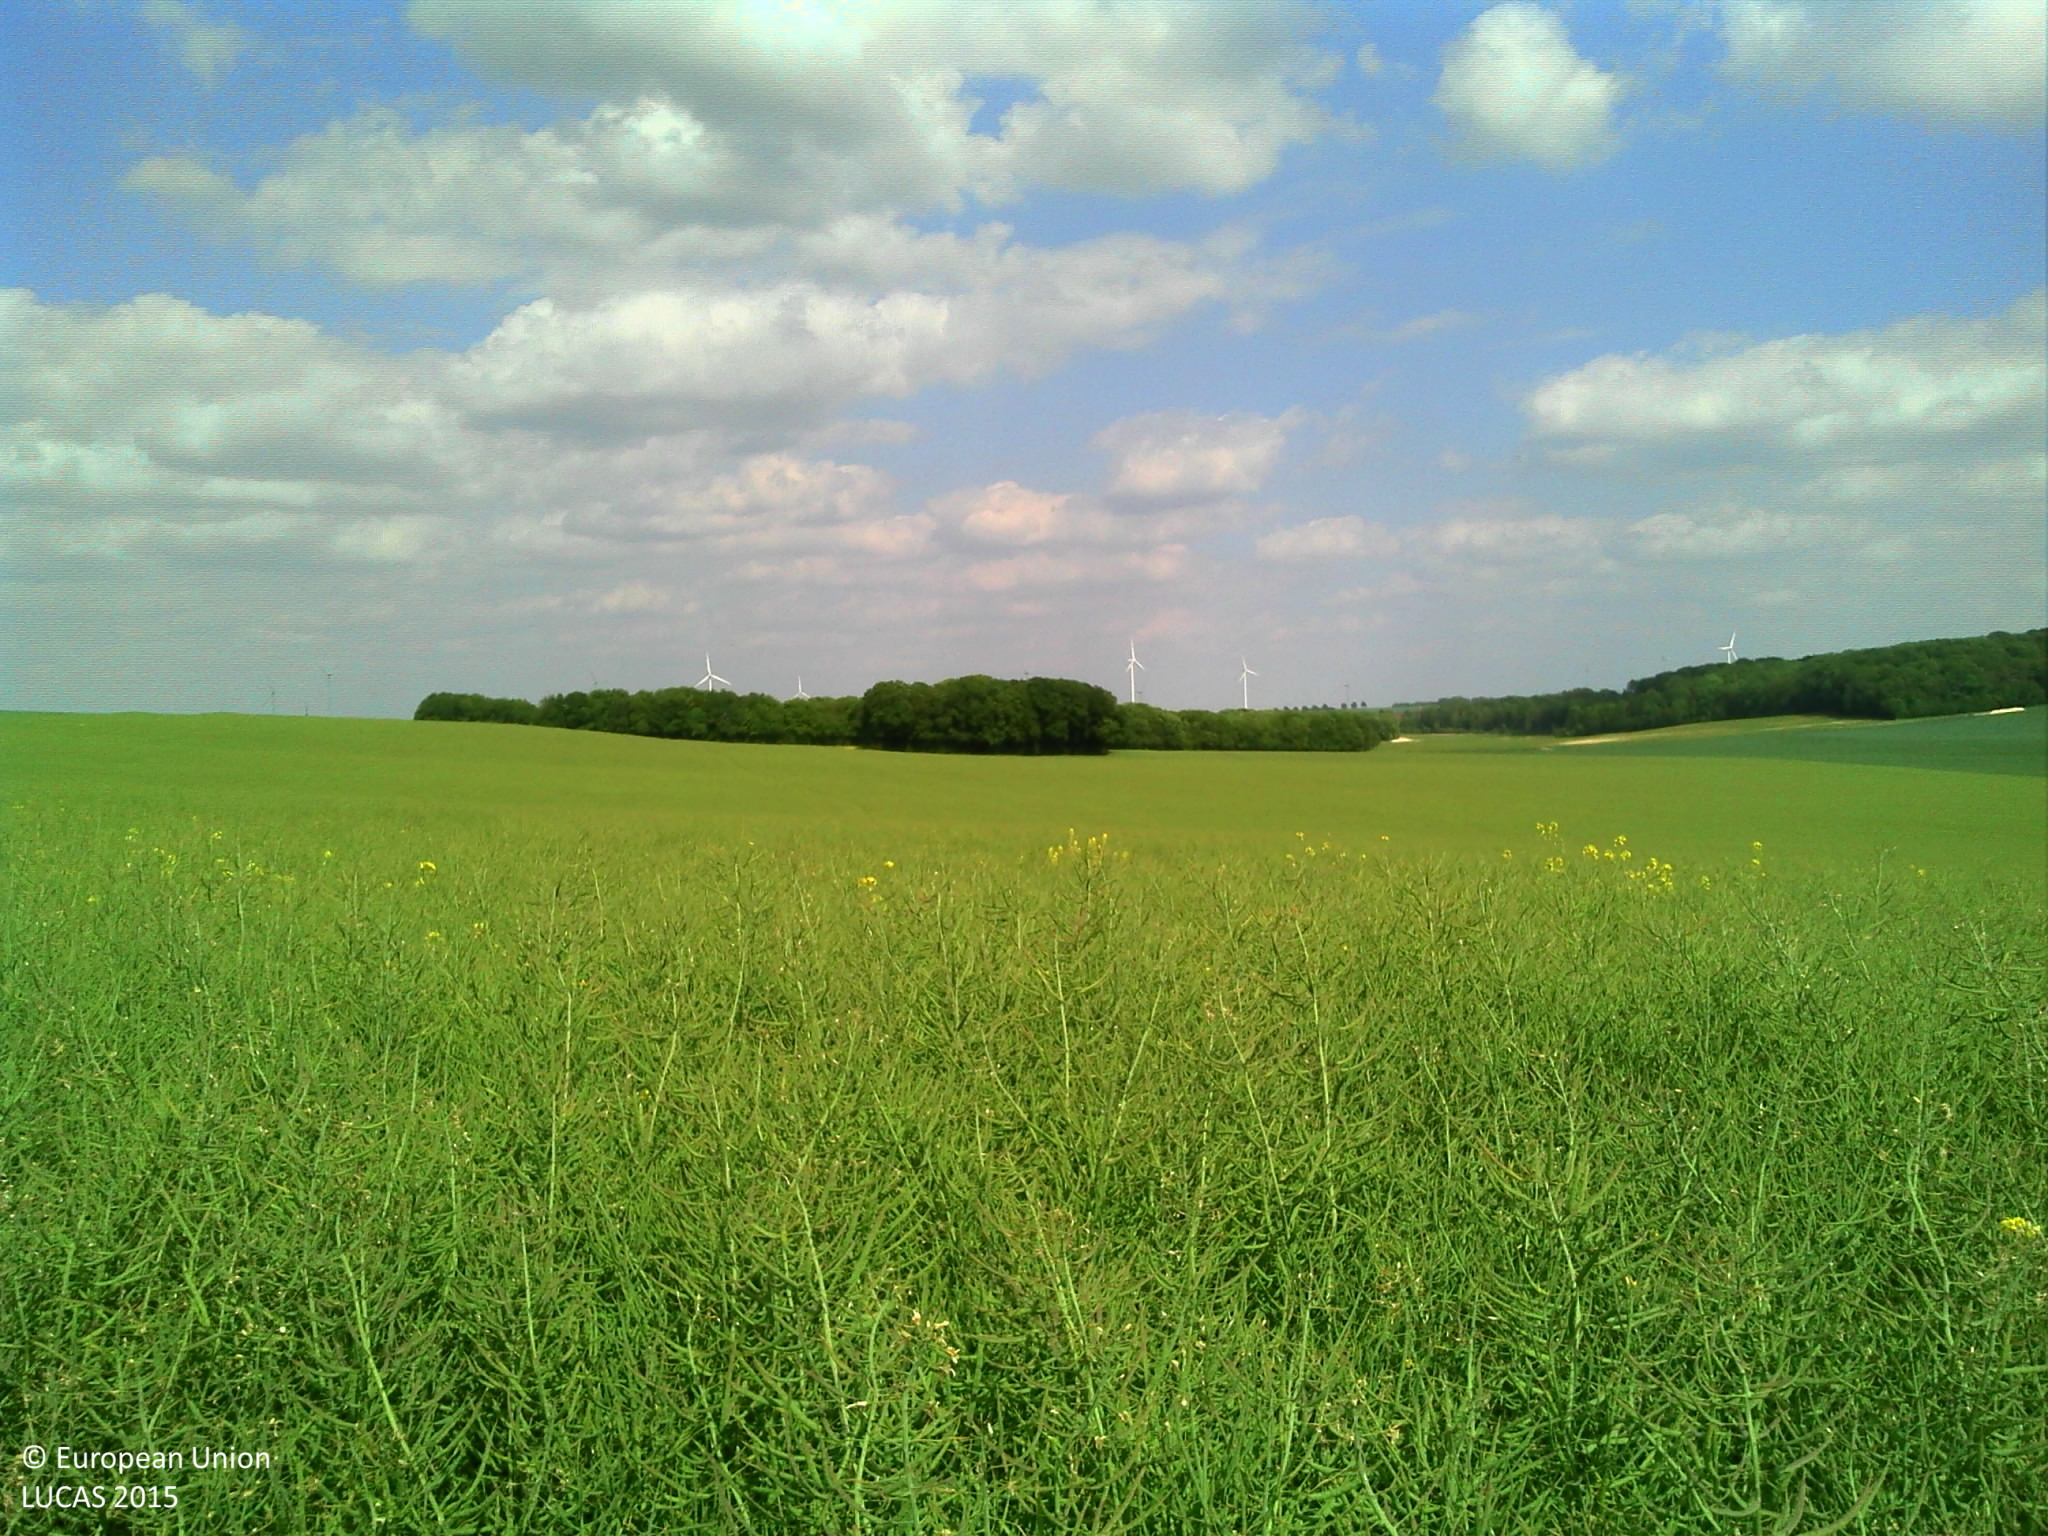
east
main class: Cropland
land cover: Rape and turnip rape
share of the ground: > 75 %
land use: Agriculture (excluding fallow land and kitchen gardens)
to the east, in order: Rape and turnip rape
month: May
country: FR
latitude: 49.8917
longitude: 3.2124
